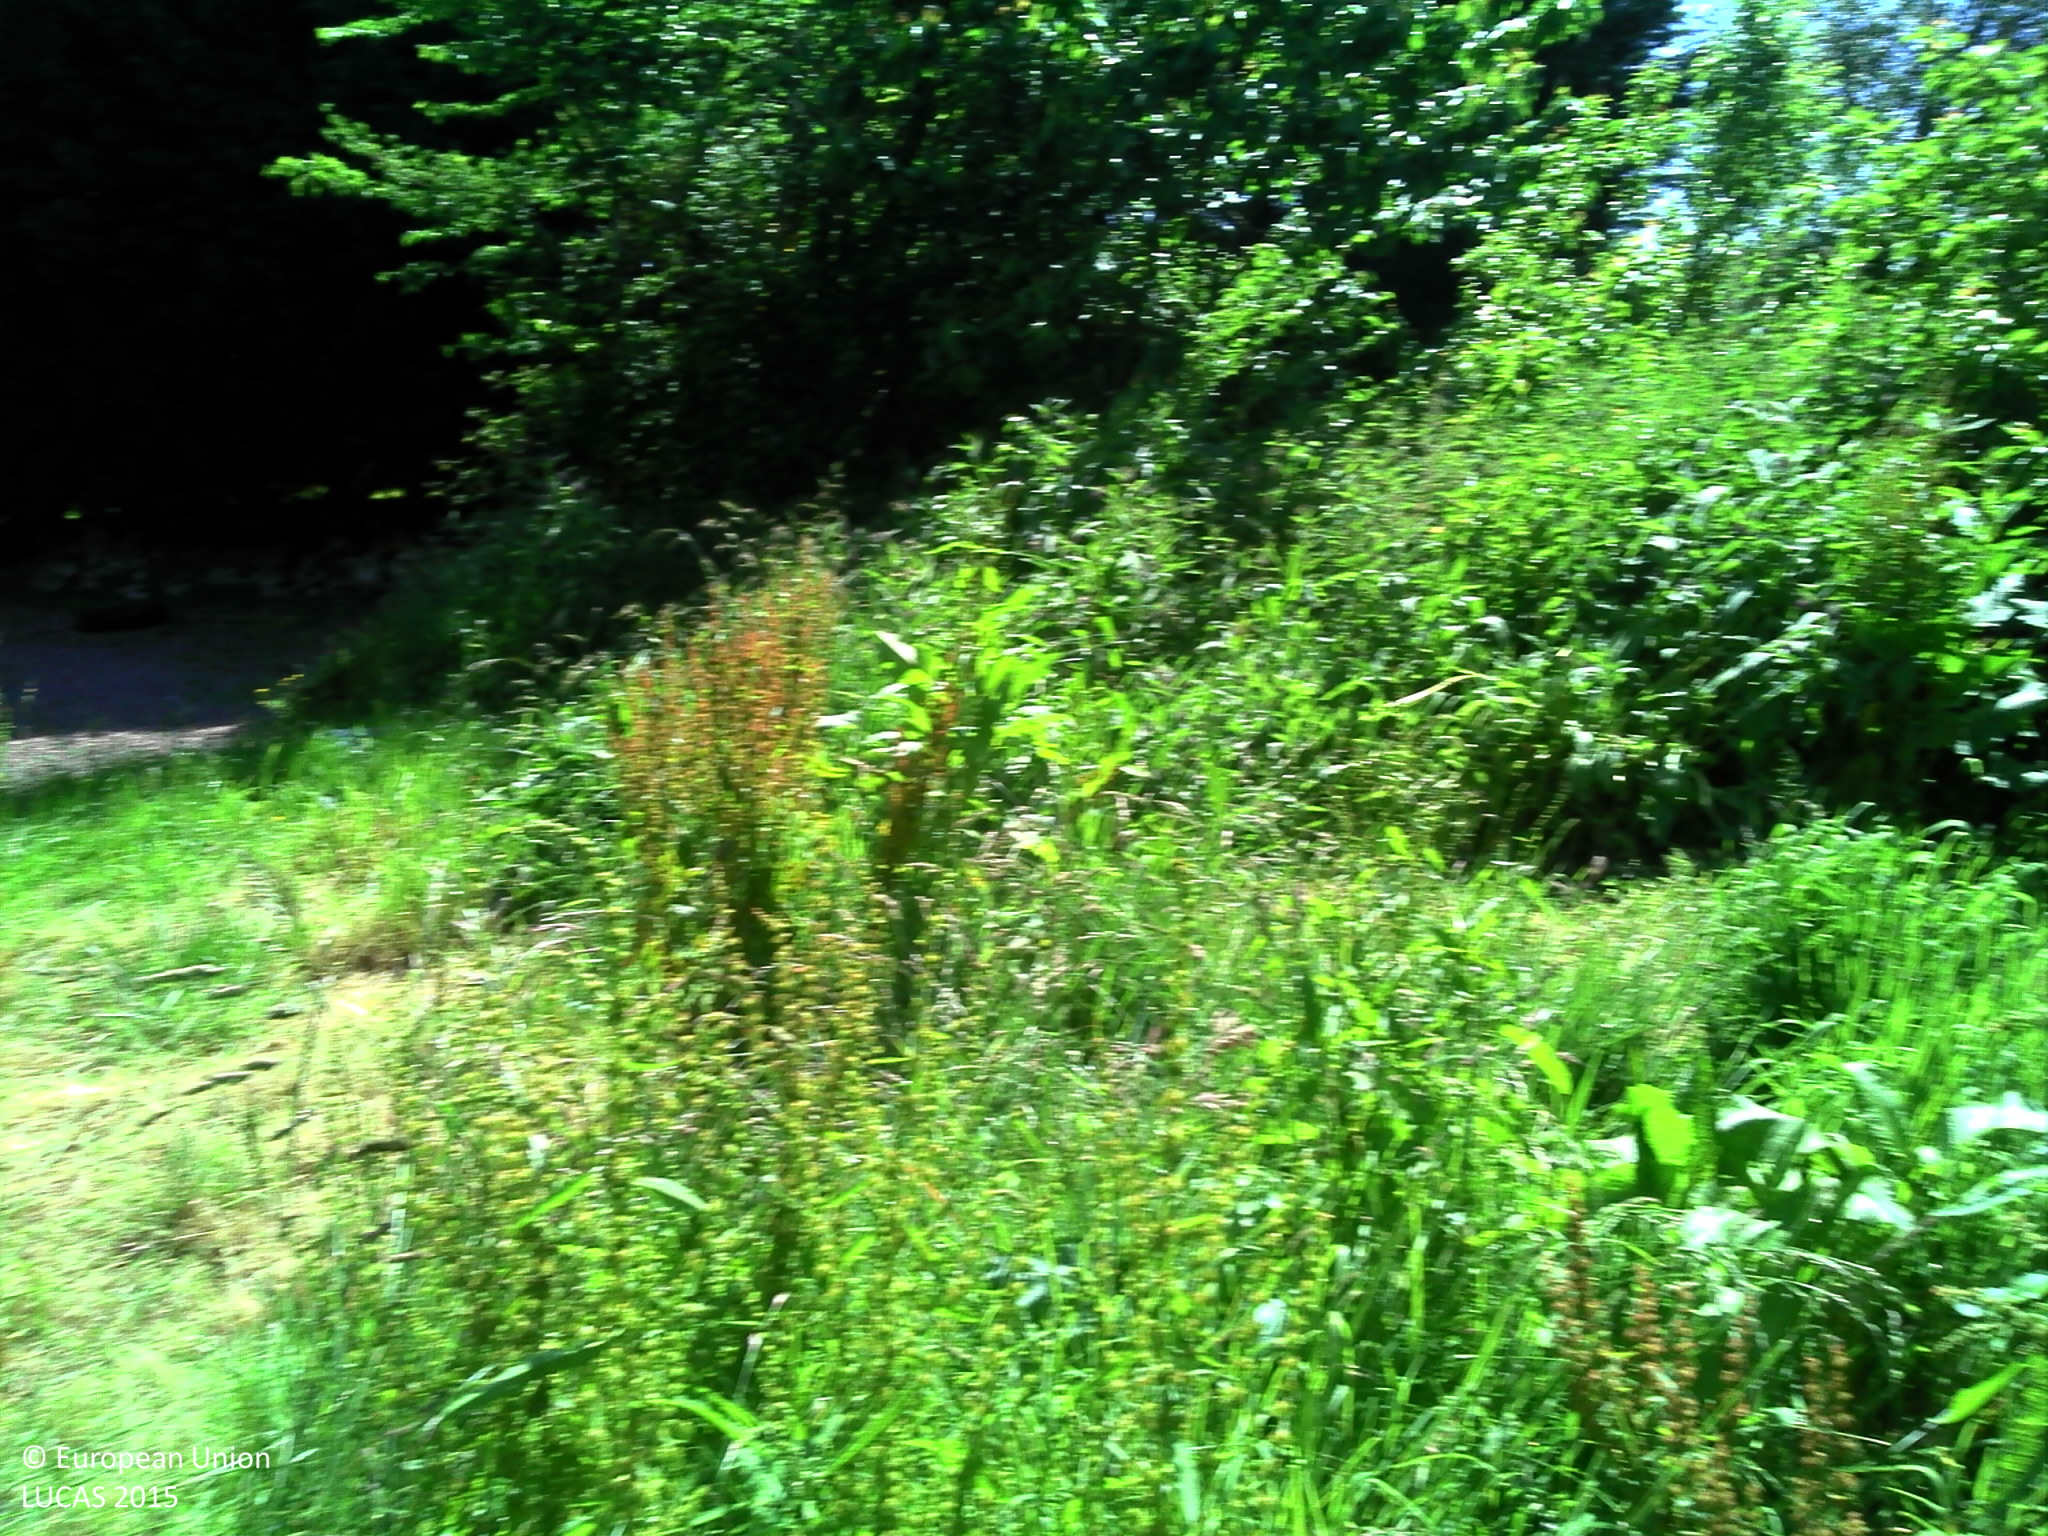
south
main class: Grassland
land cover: Spontaneously vegetated surfaces
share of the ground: > 75 %
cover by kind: herbaceous plants 100 %
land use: Residential
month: June
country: FR
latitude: 49.4896
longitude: -1.6897
